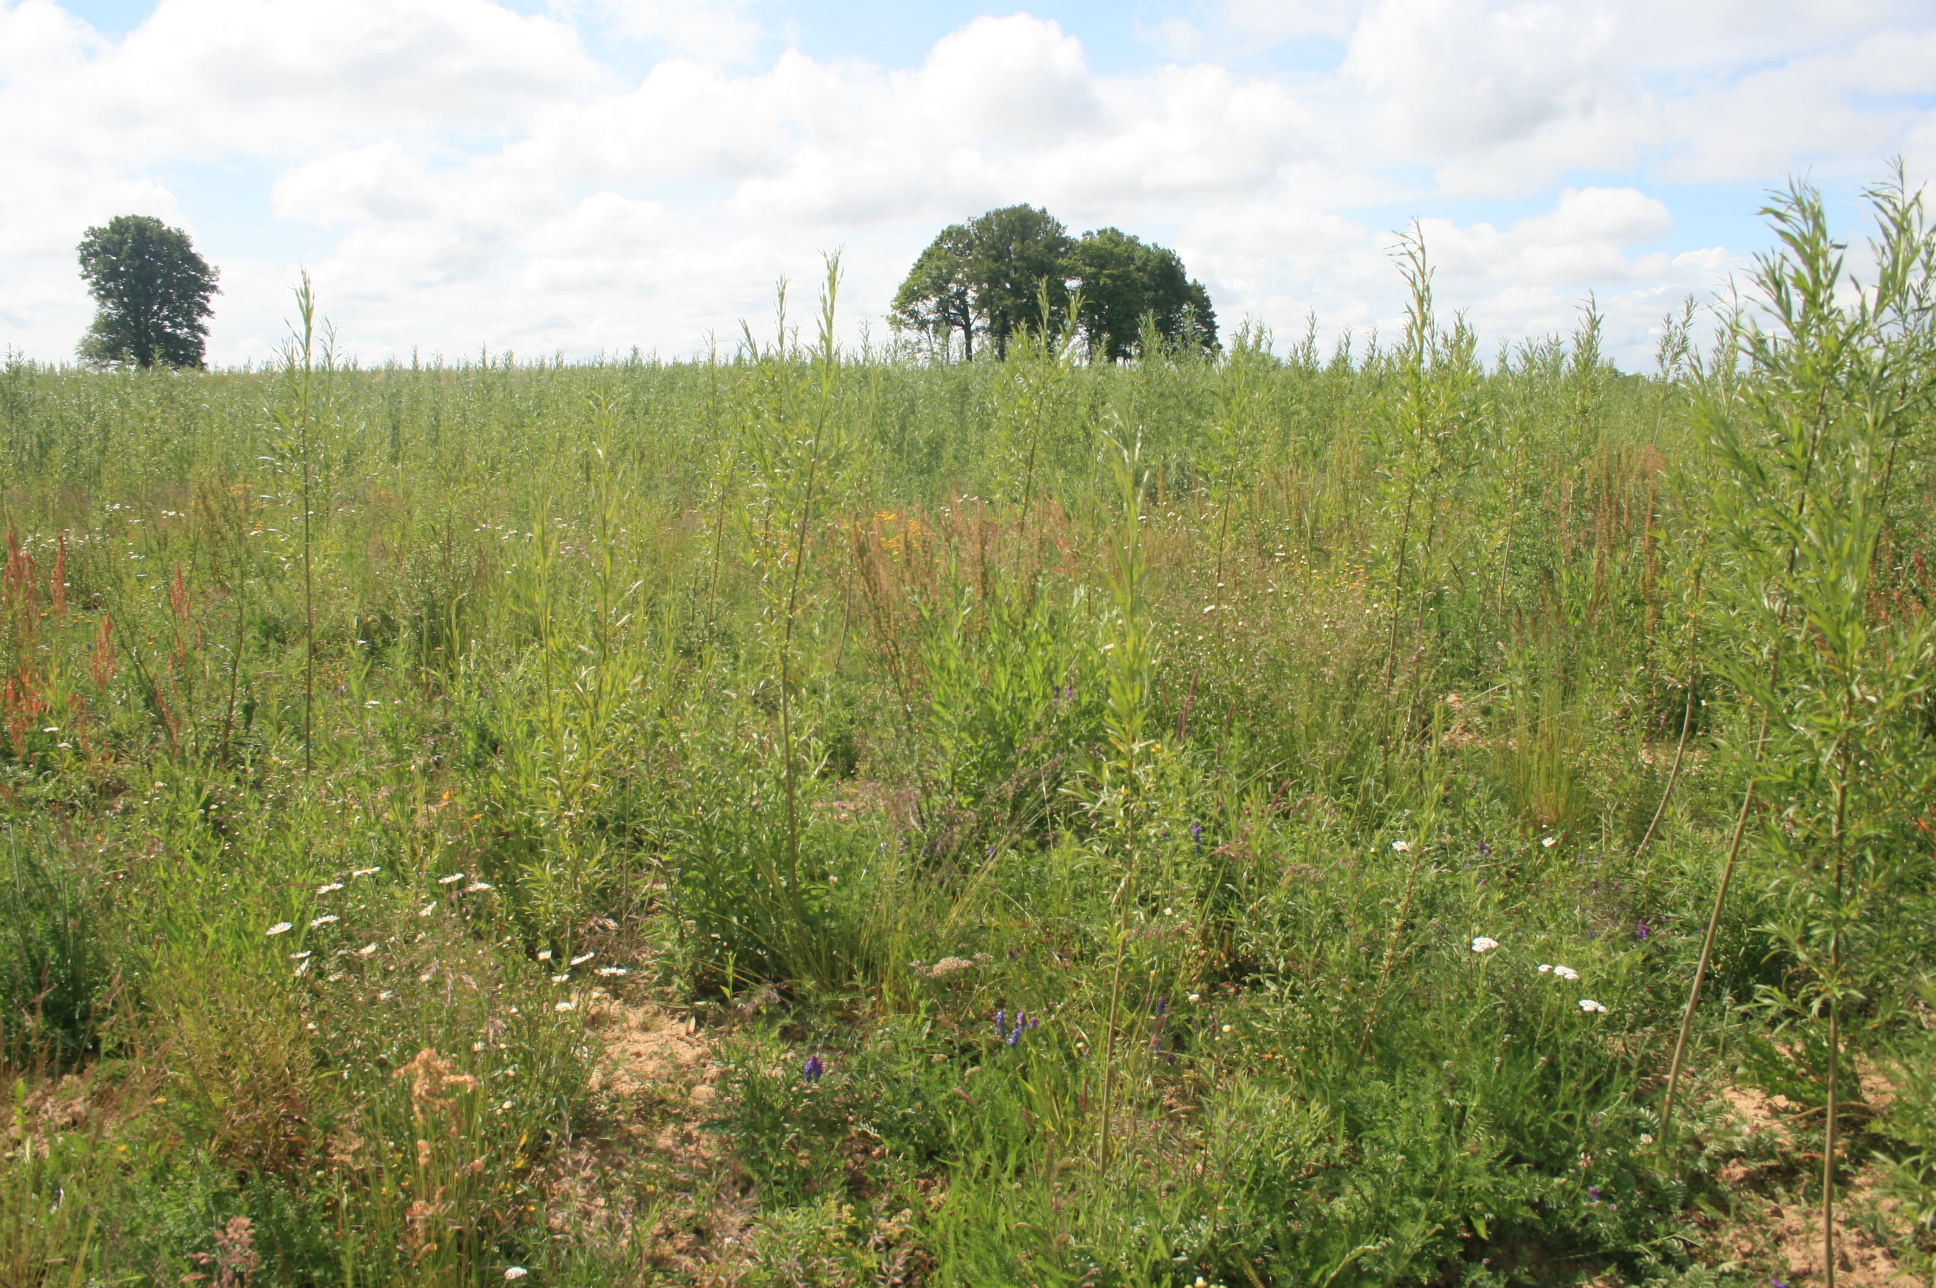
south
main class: Shrubland
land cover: Shrubland without tree cover
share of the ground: 50 - 75 %
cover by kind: shrubs 60 %, herbaceous plants 40 %
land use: Abandoned areas
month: June
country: LT
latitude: 55.2496
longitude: 22.0894
